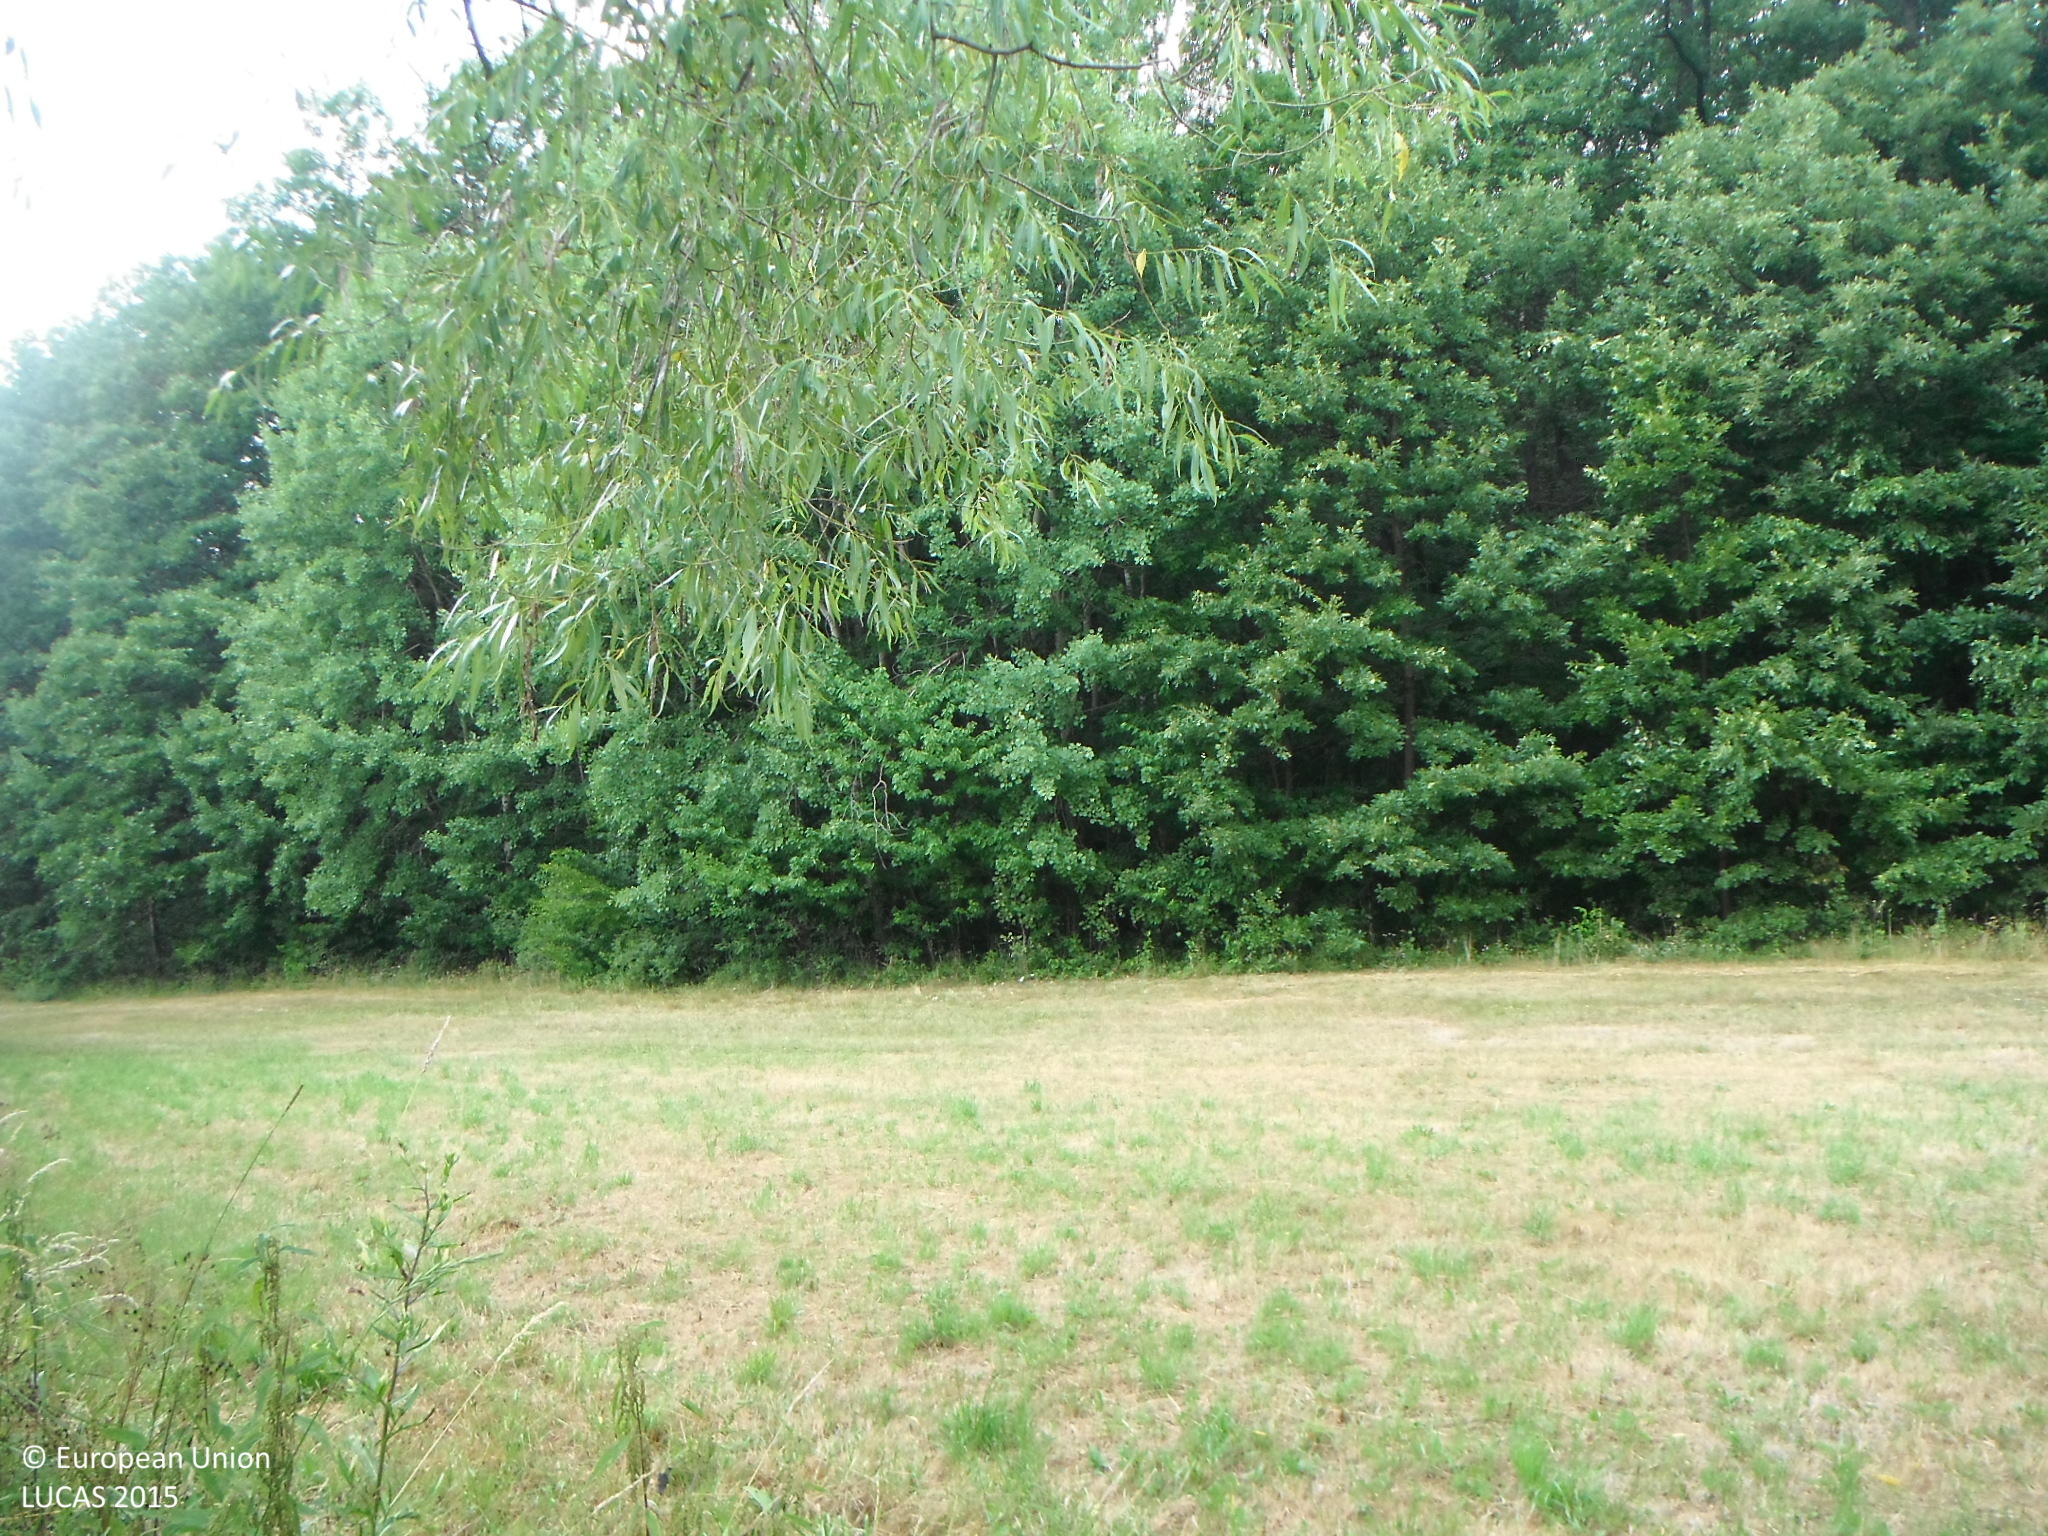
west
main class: Woodland
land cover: Broadleaved woodland
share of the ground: > 75 %
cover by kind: broadleaved forest trees 90 %, herbaceous plants 10 %
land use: Semi-natural and natural areas not in use
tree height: > 5 m
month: July
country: SK
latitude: 48.3666
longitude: 19.1599
